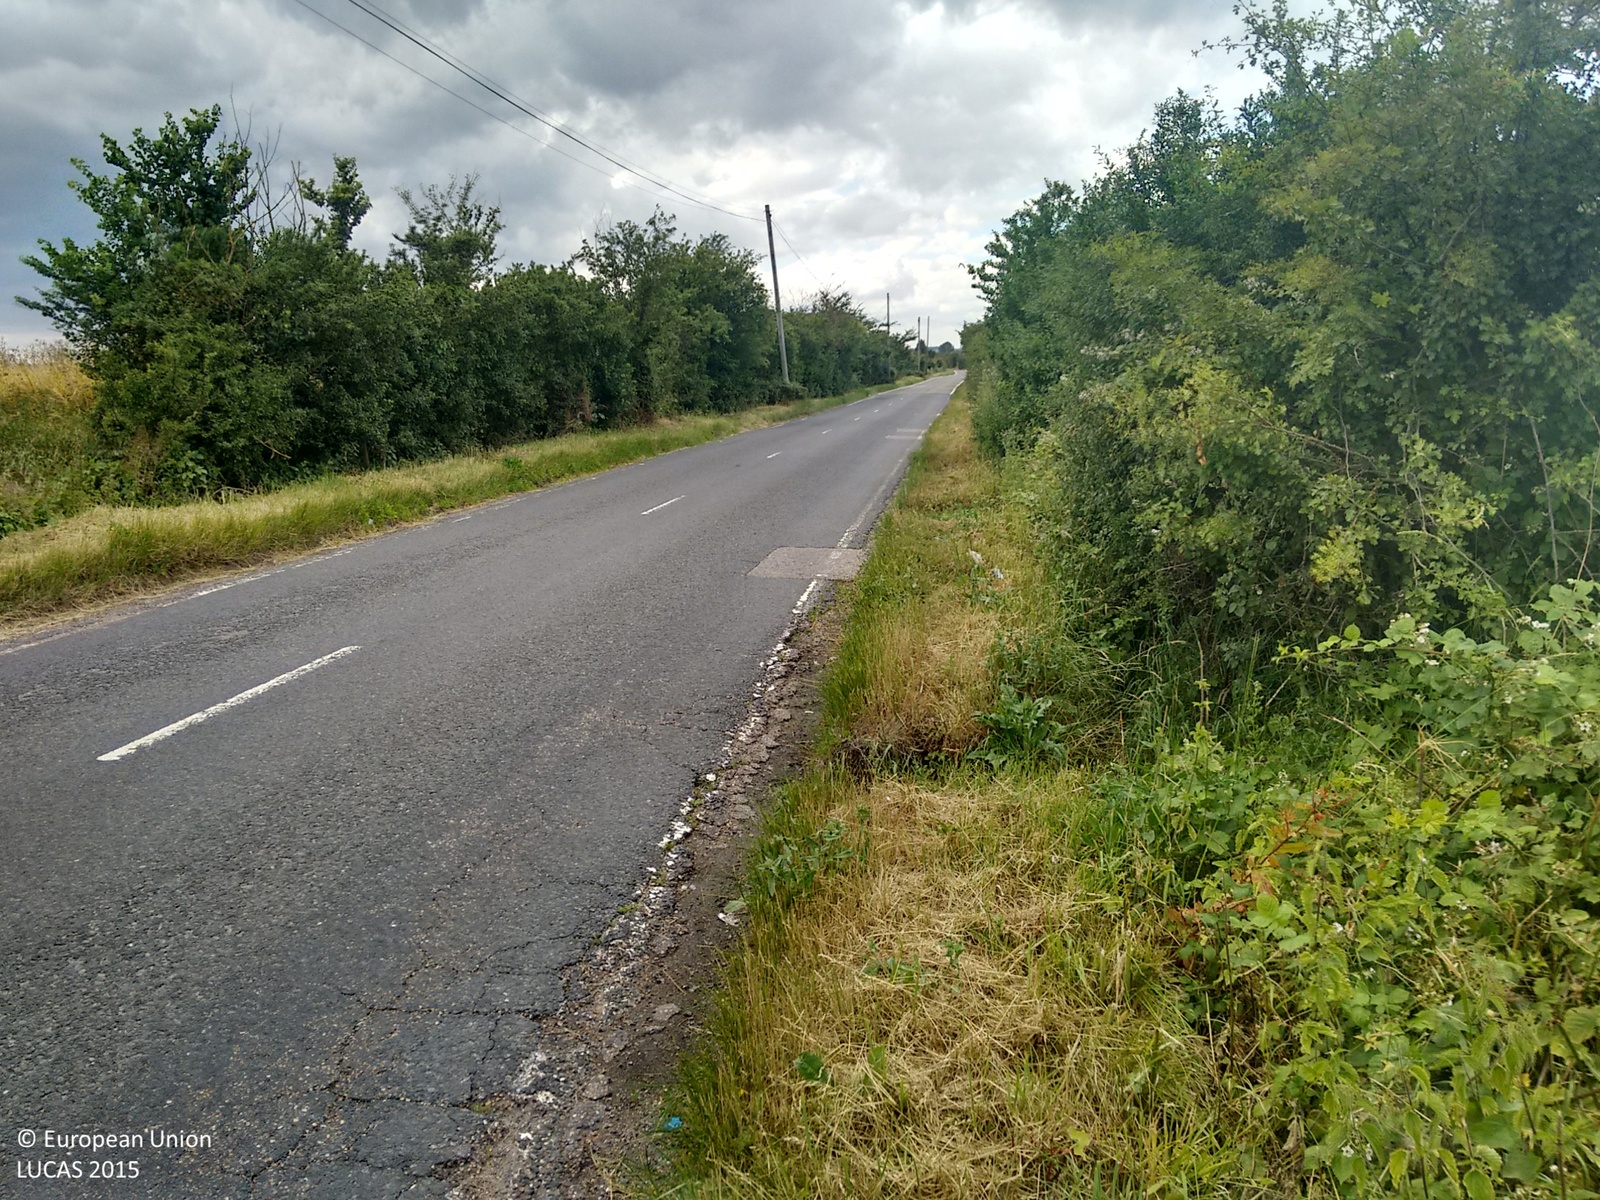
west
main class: Cropland
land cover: Barley
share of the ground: > 75 %
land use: Agriculture (excluding fallow land and kitchen gardens)
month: July
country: GB
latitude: 51.5514
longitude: 0.3805
